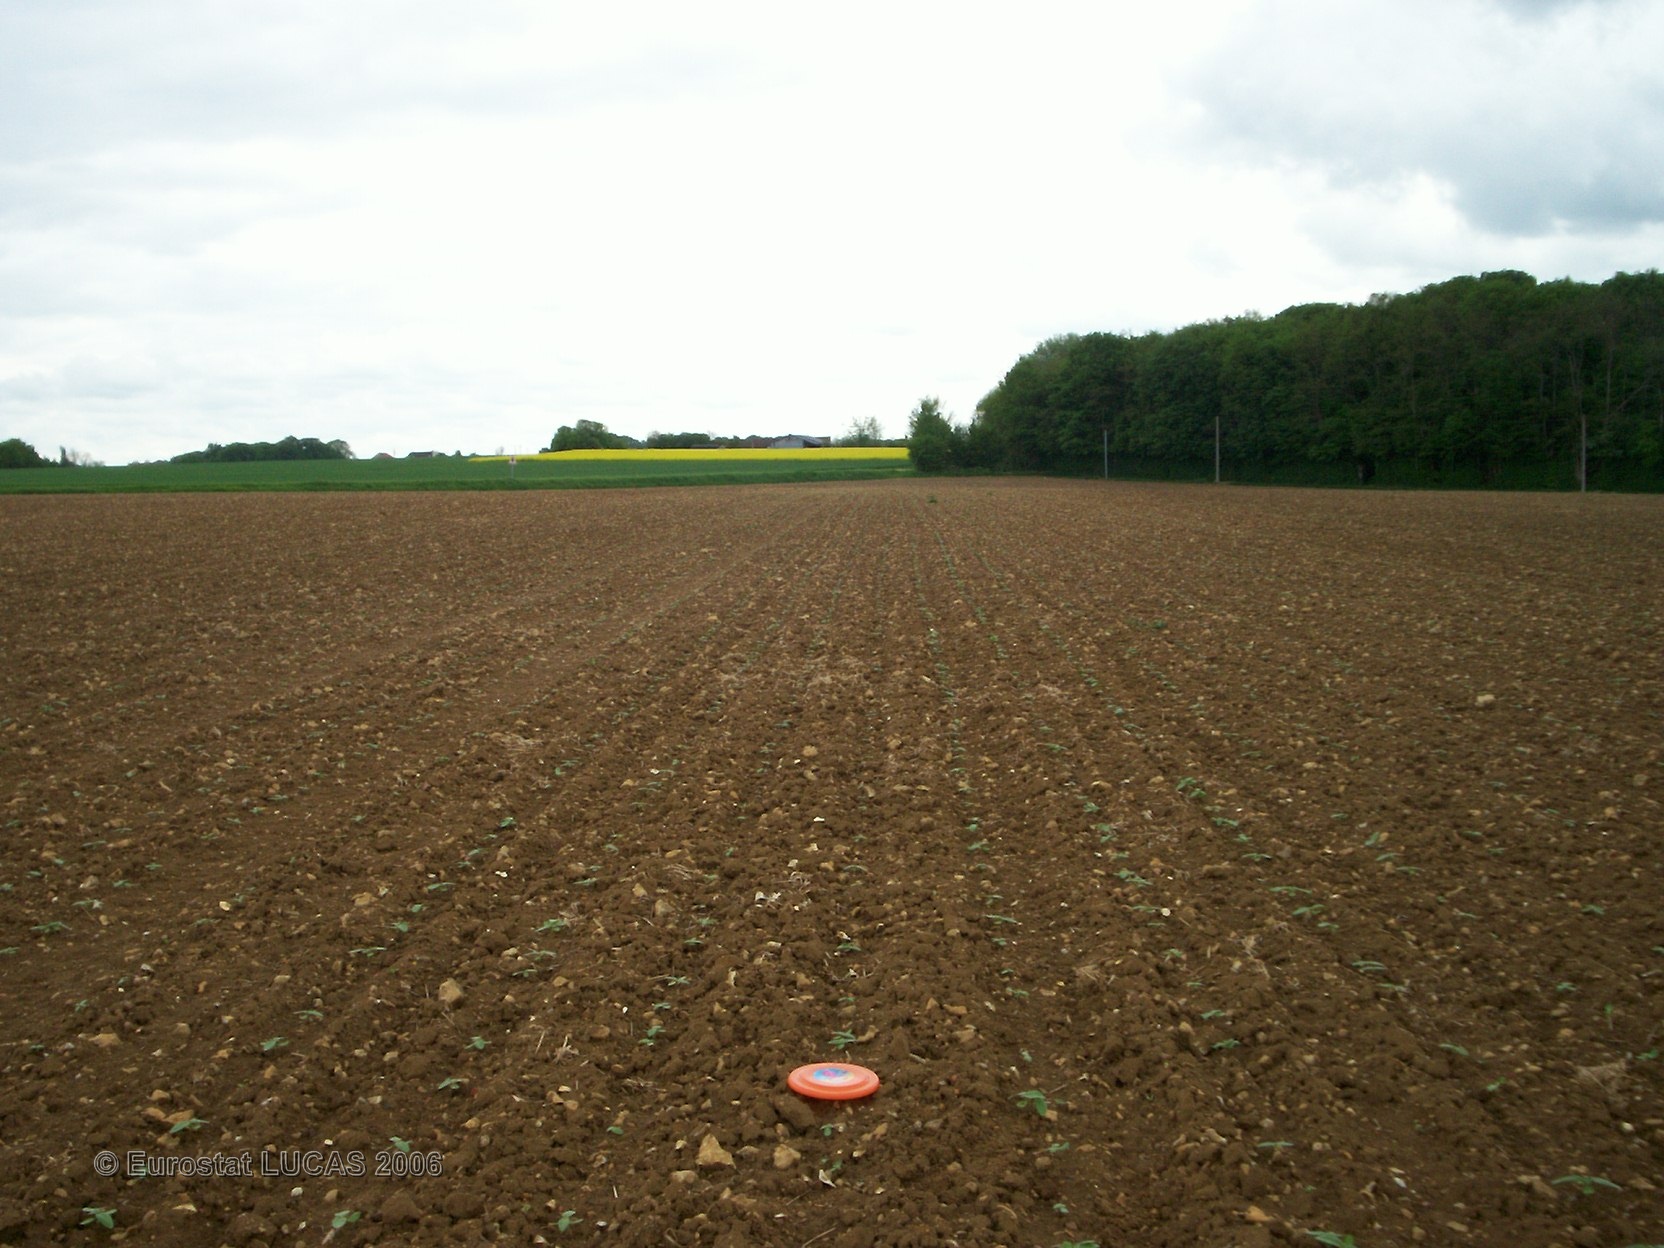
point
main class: Cropland
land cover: Sunflower
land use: Agriculture (excluding fallow land and kitchen gardens)
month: May
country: FR
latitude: 48.0178
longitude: 2.9809
